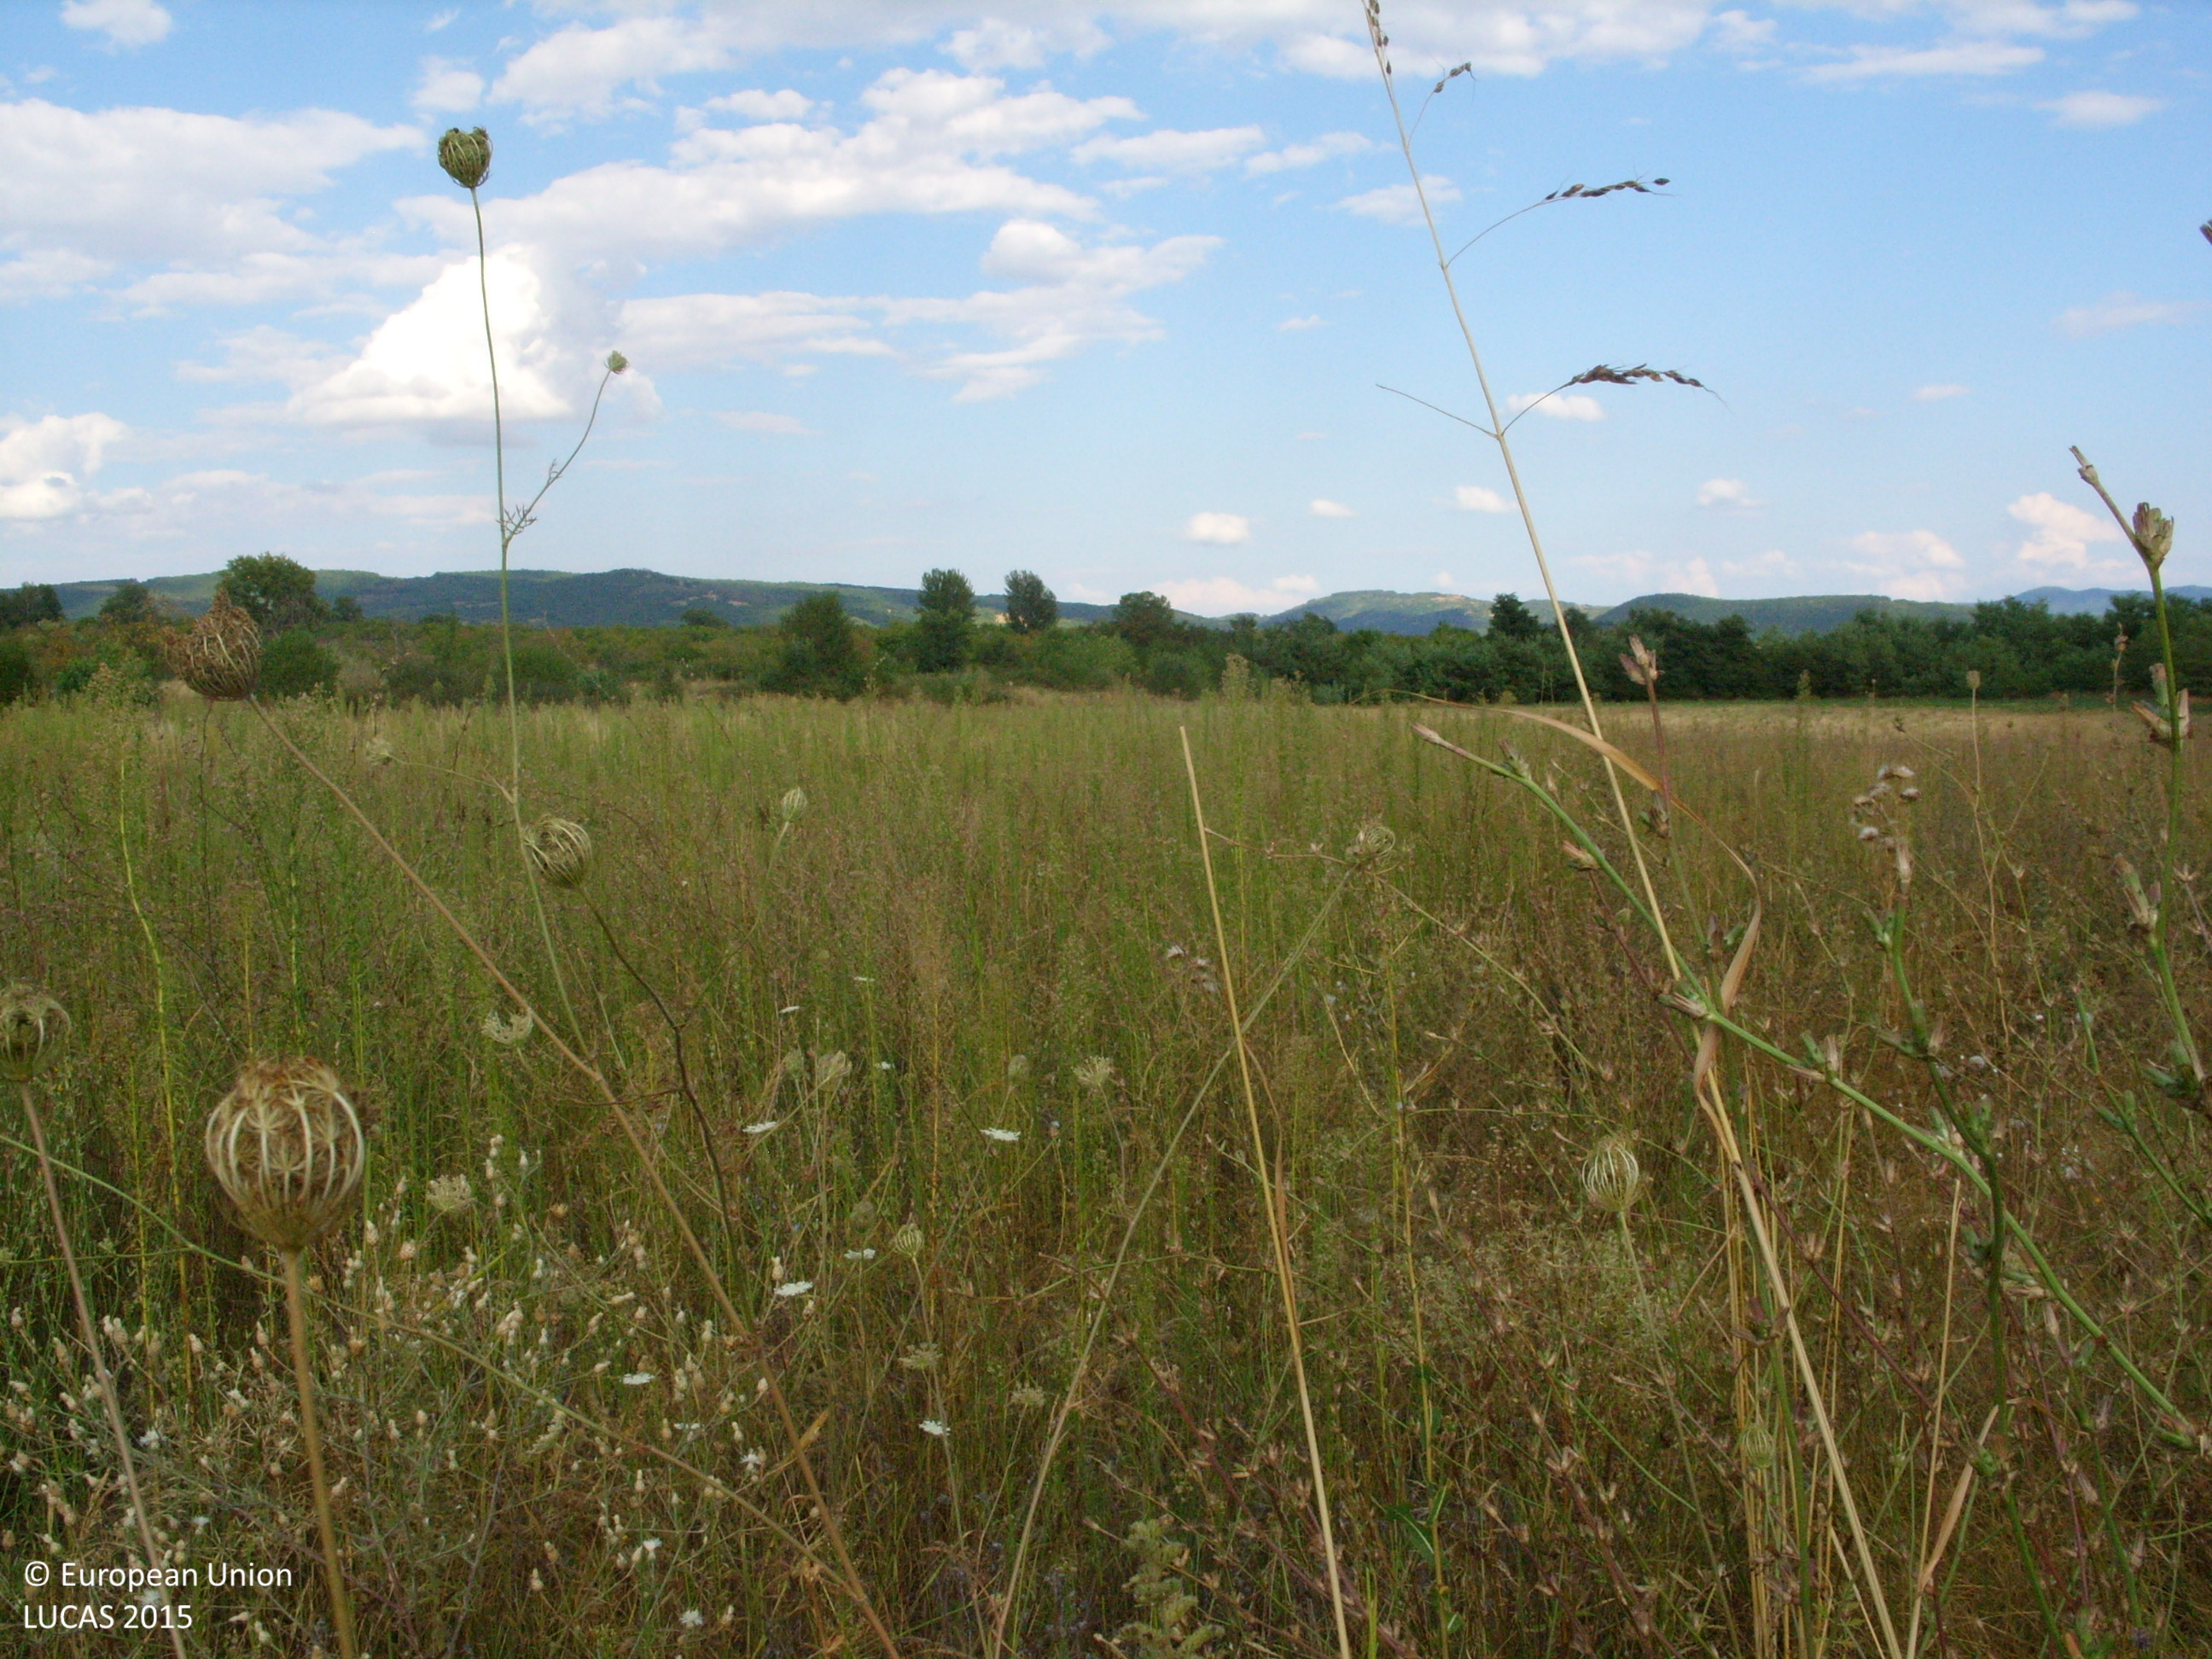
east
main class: Grassland
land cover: Spontaneously vegetated surfaces
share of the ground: > 75 %
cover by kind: herbaceous plants 100 %
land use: Fallow land
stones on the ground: < 10 %
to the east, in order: Spontaneously vegetated surfaces; Abandoned hedges; Paved roads, cycling and walking lanes; Grassland without tree/shrub cover; Tracks; Broadleaved woodland; Grassland without tree/shrub cover
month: August
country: BG
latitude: 42.6124
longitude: 24.8704
